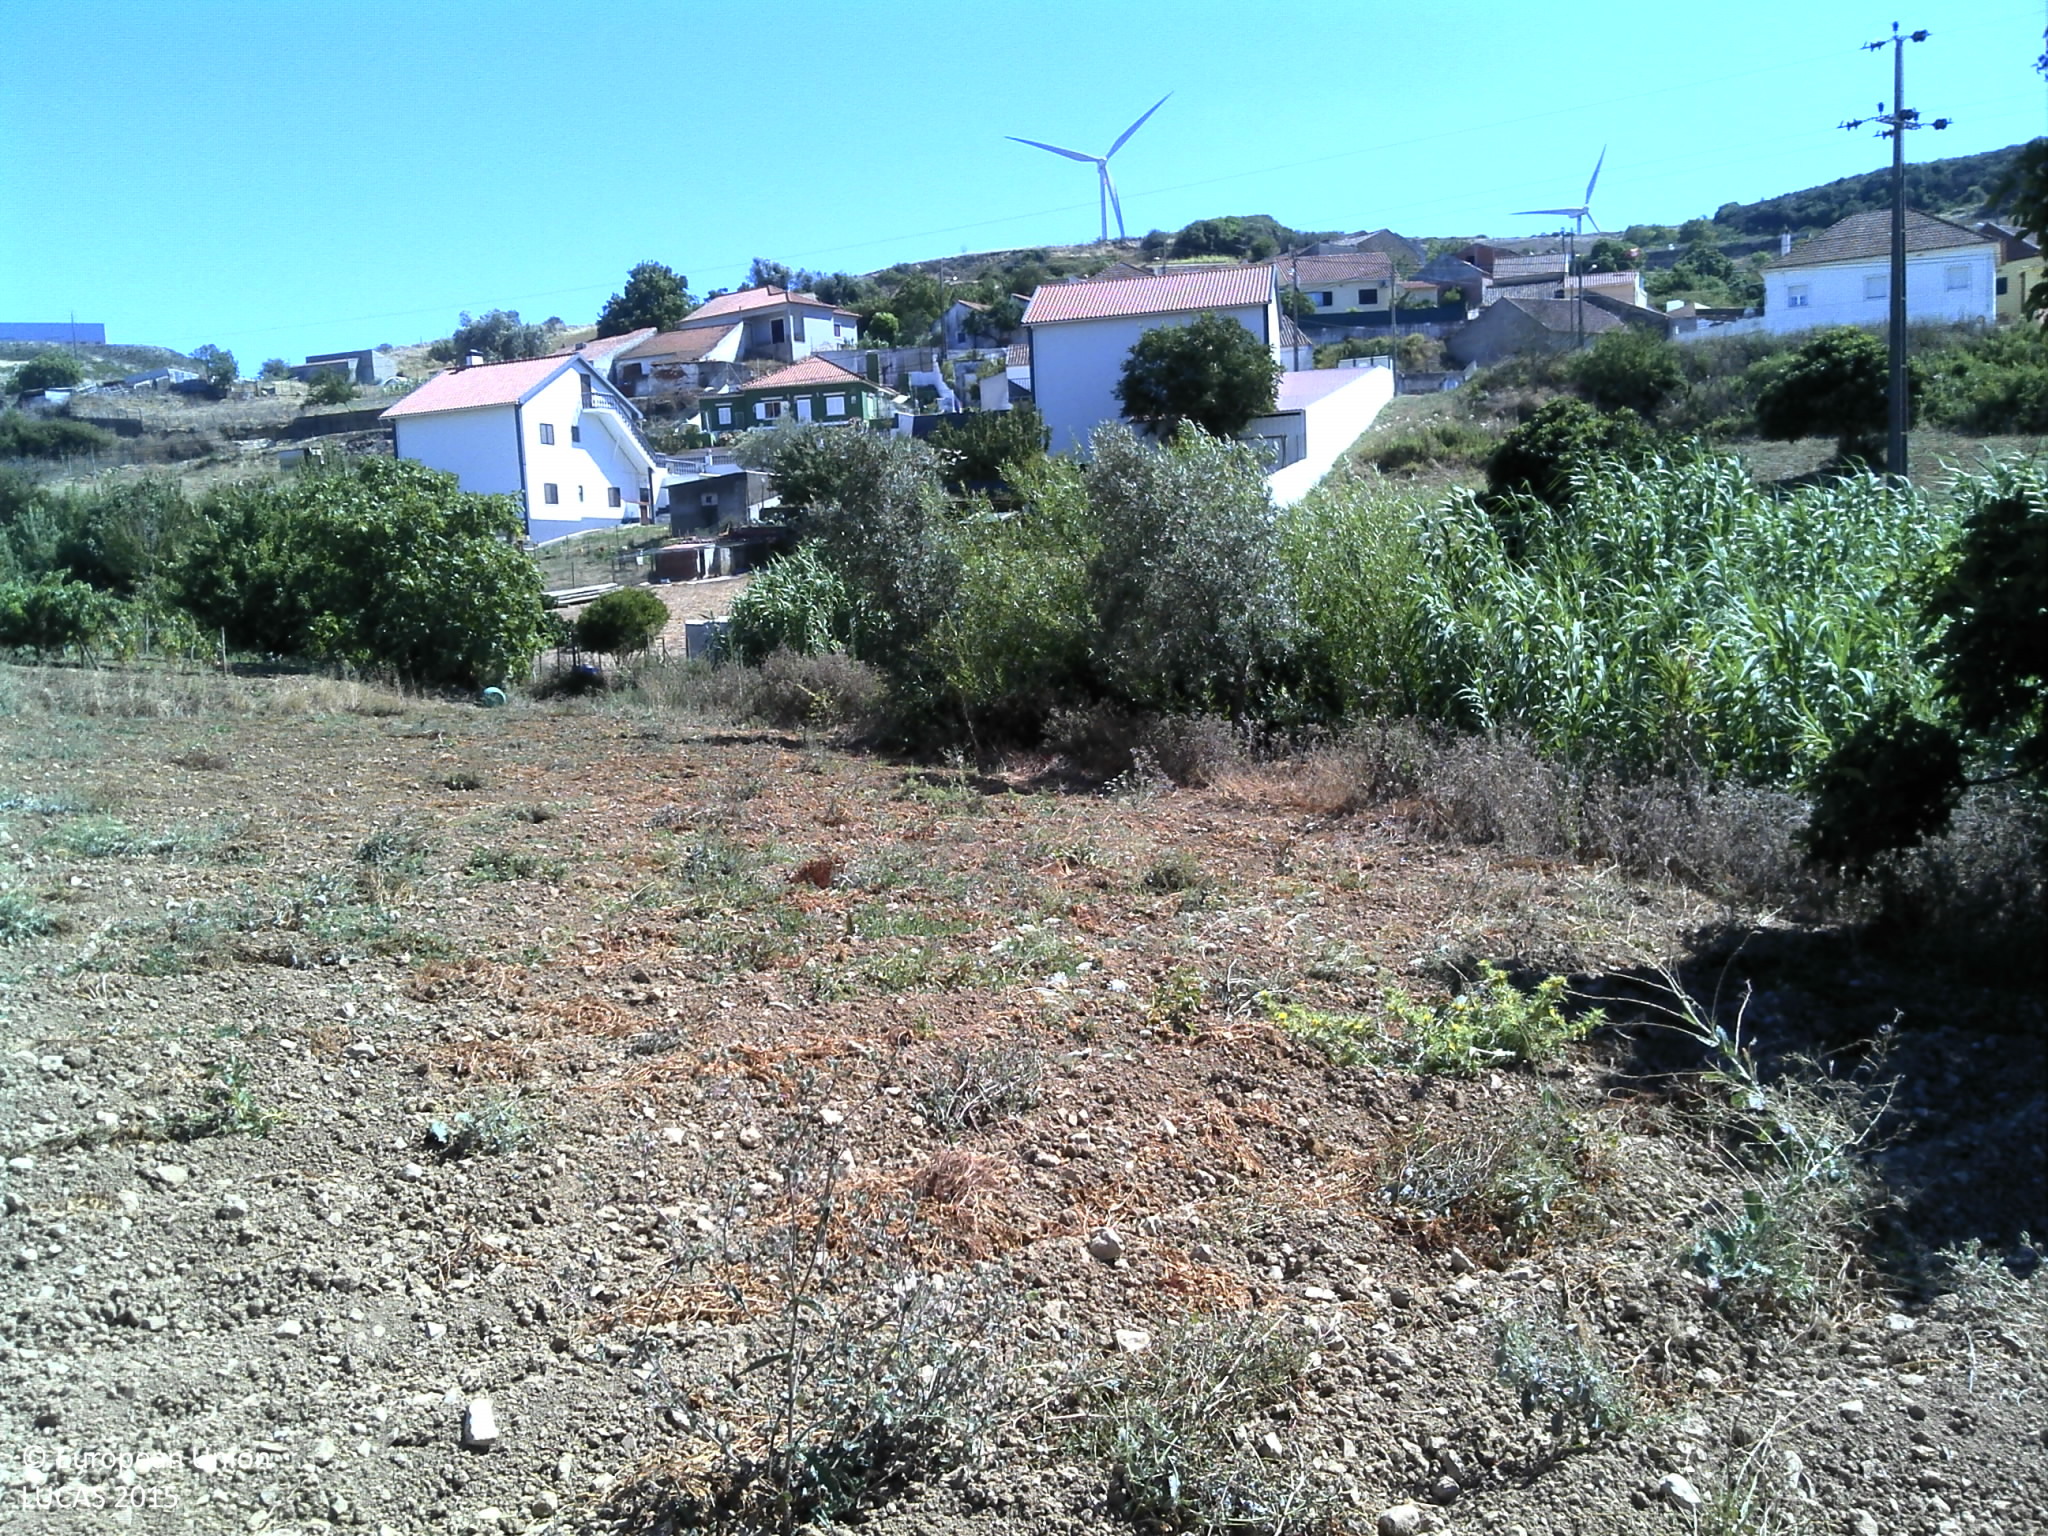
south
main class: Grassland
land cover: Spontaneously vegetated surfaces
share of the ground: 10 - 25 %
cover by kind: unconsolidated bare surface 75 %, herbaceous plants 15 %
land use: Fallow land
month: July
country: PT
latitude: 38.9835
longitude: -9.1873
